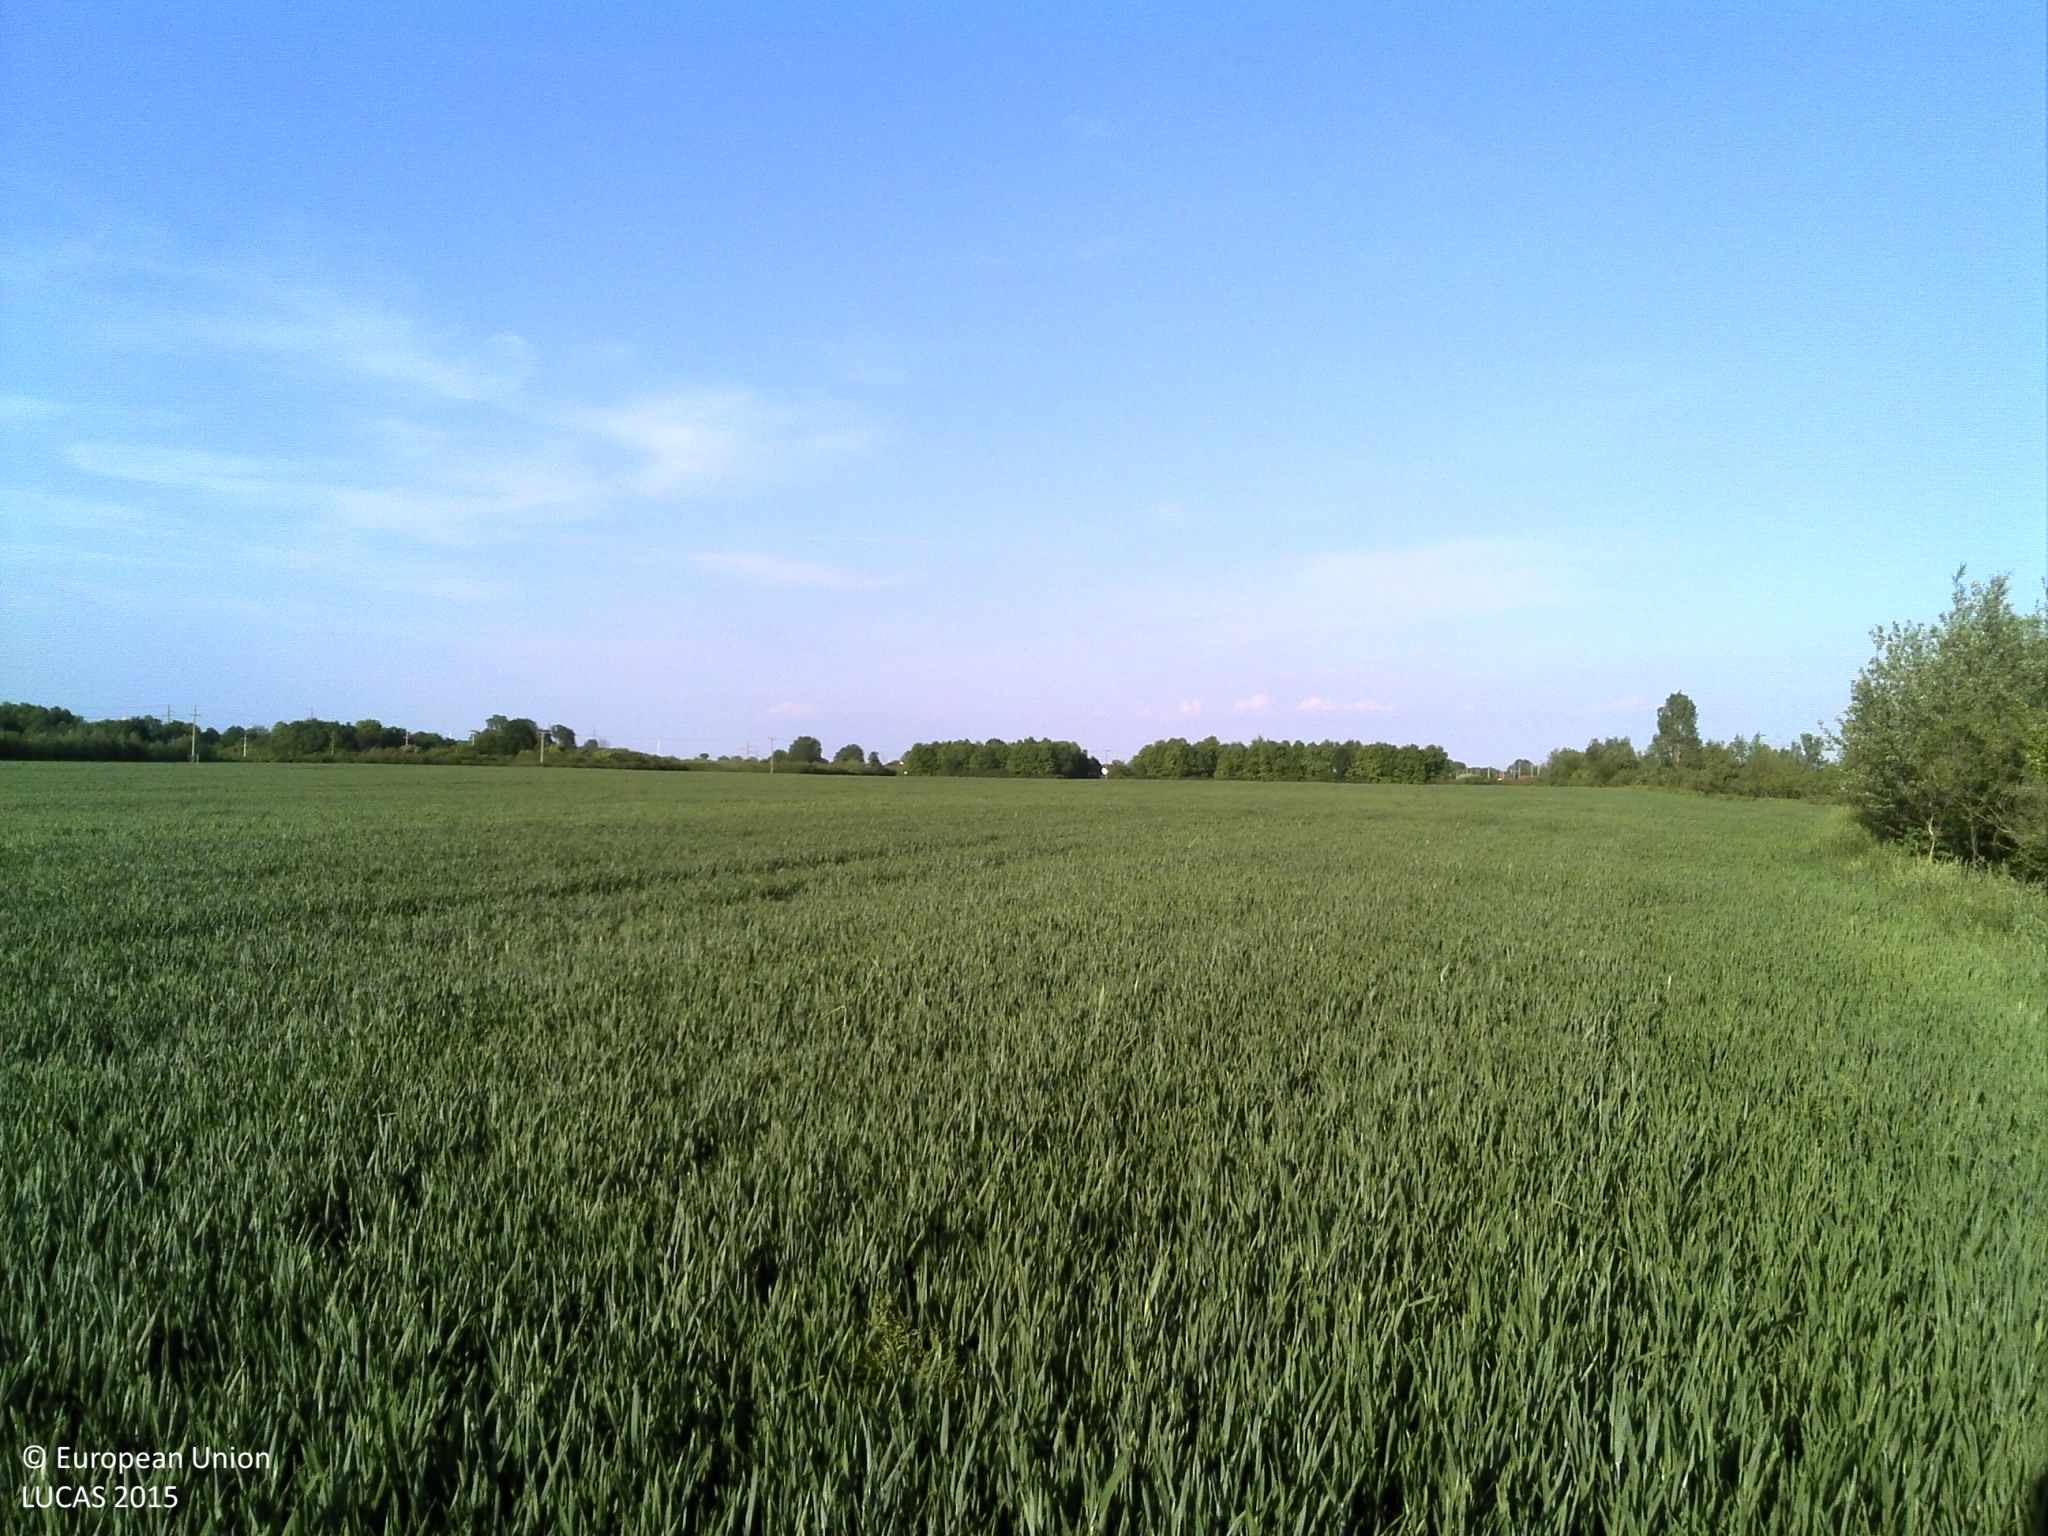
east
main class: Cropland
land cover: Common wheat
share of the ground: > 75 %
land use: Agriculture (excluding fallow land and kitchen gardens)
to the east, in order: Common wheat; Shruby margins; Ditches and canals; Shruby margins; Arable land (only in case pi); Shrubland with sparse tree cover
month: May
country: HR
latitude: 45.1821
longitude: 18.2375
